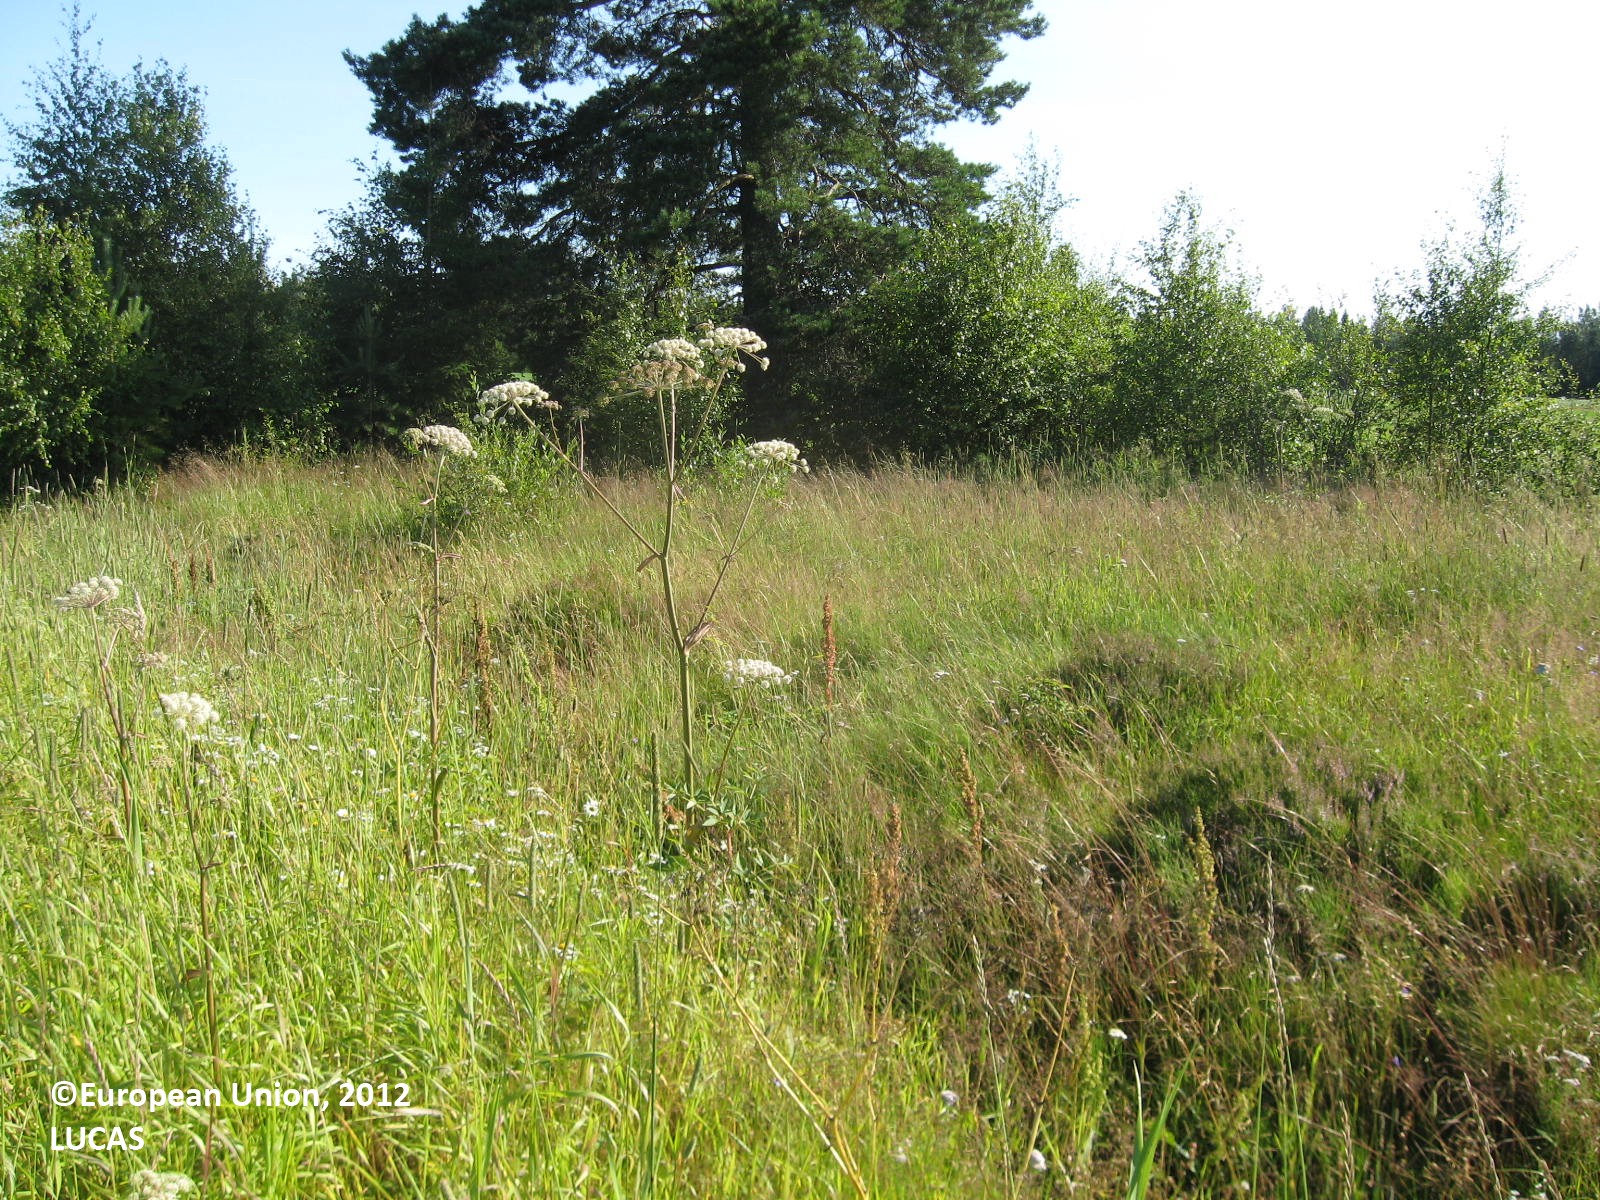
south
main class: Cropland
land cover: Oats
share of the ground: > 75 %
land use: Agriculture (excluding fallow land and kitchen gardens)
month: July
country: FI
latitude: 62.0516
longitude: 22.5105
